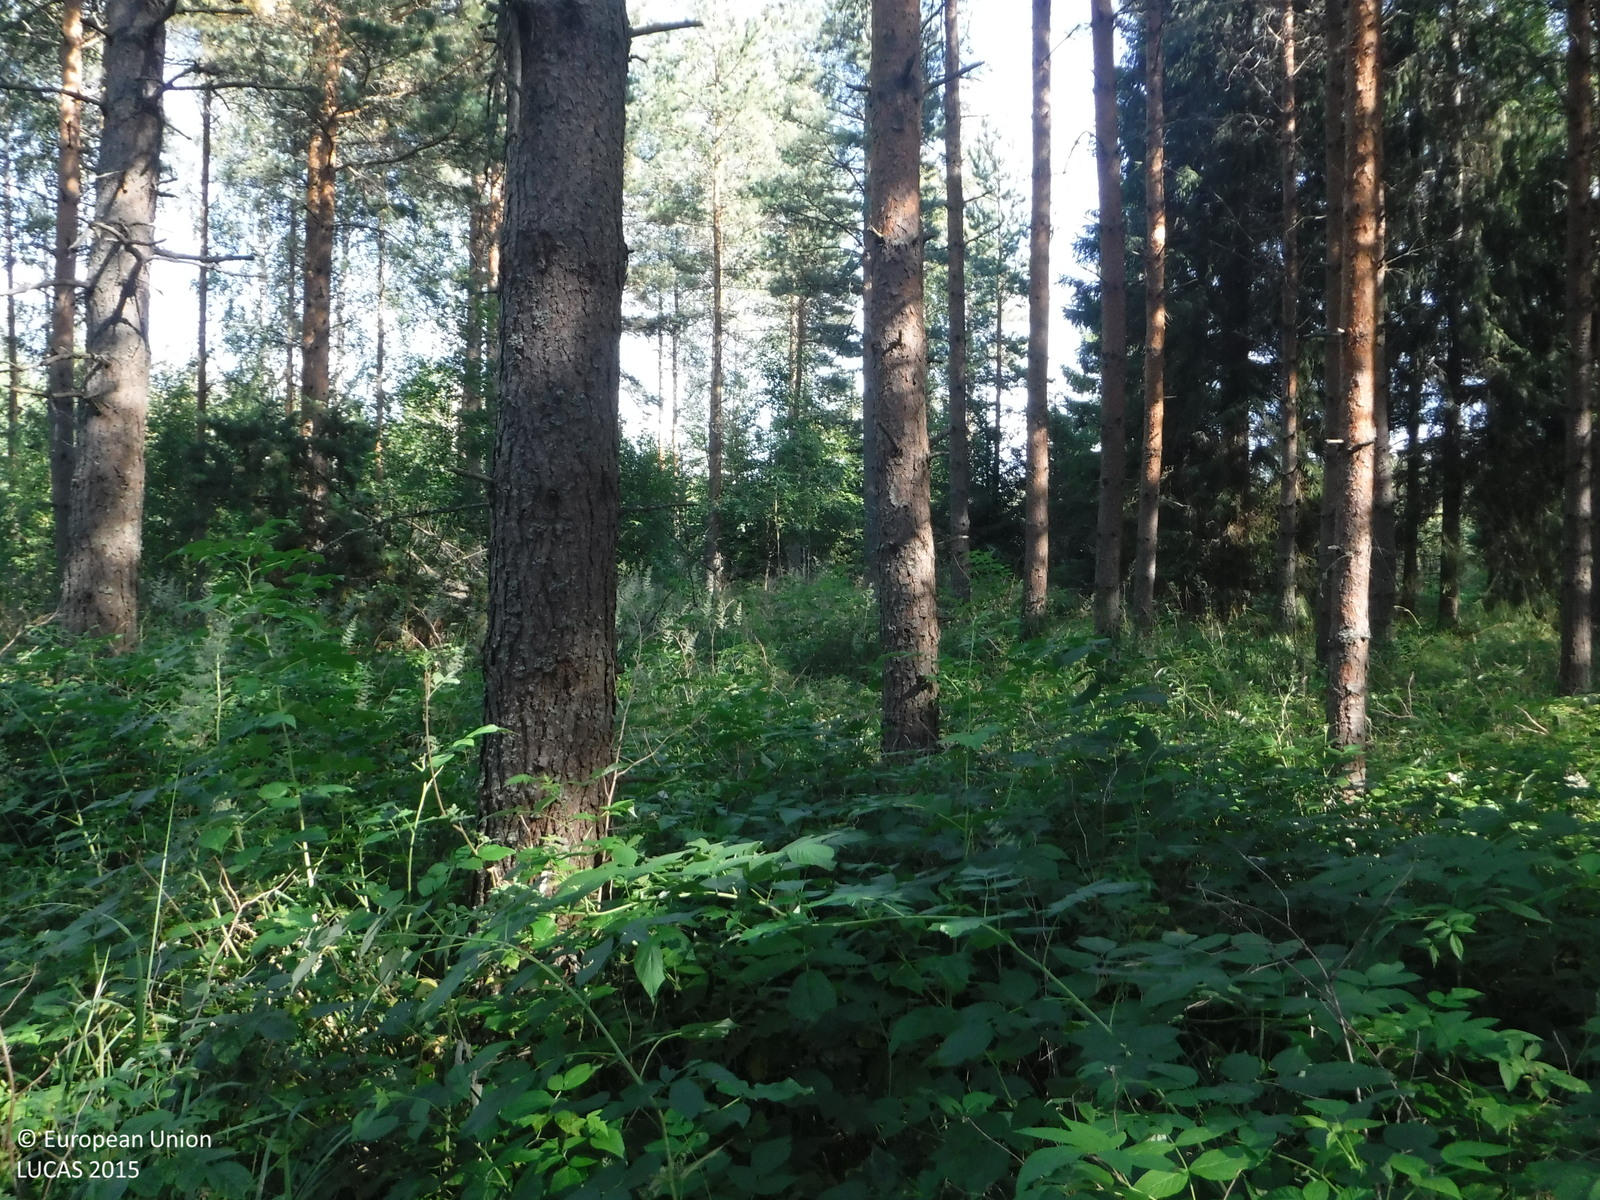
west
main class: Woodland
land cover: Pine dominated coniferous woodland
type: boreal forest
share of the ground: 50 - 75 %
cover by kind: coniferous forest trees 65 %, shrubs 30 %, herbaceous plants 5 %
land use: Forestry
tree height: > 5 m
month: August
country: FI
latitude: 61.0823
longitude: 21.4165
